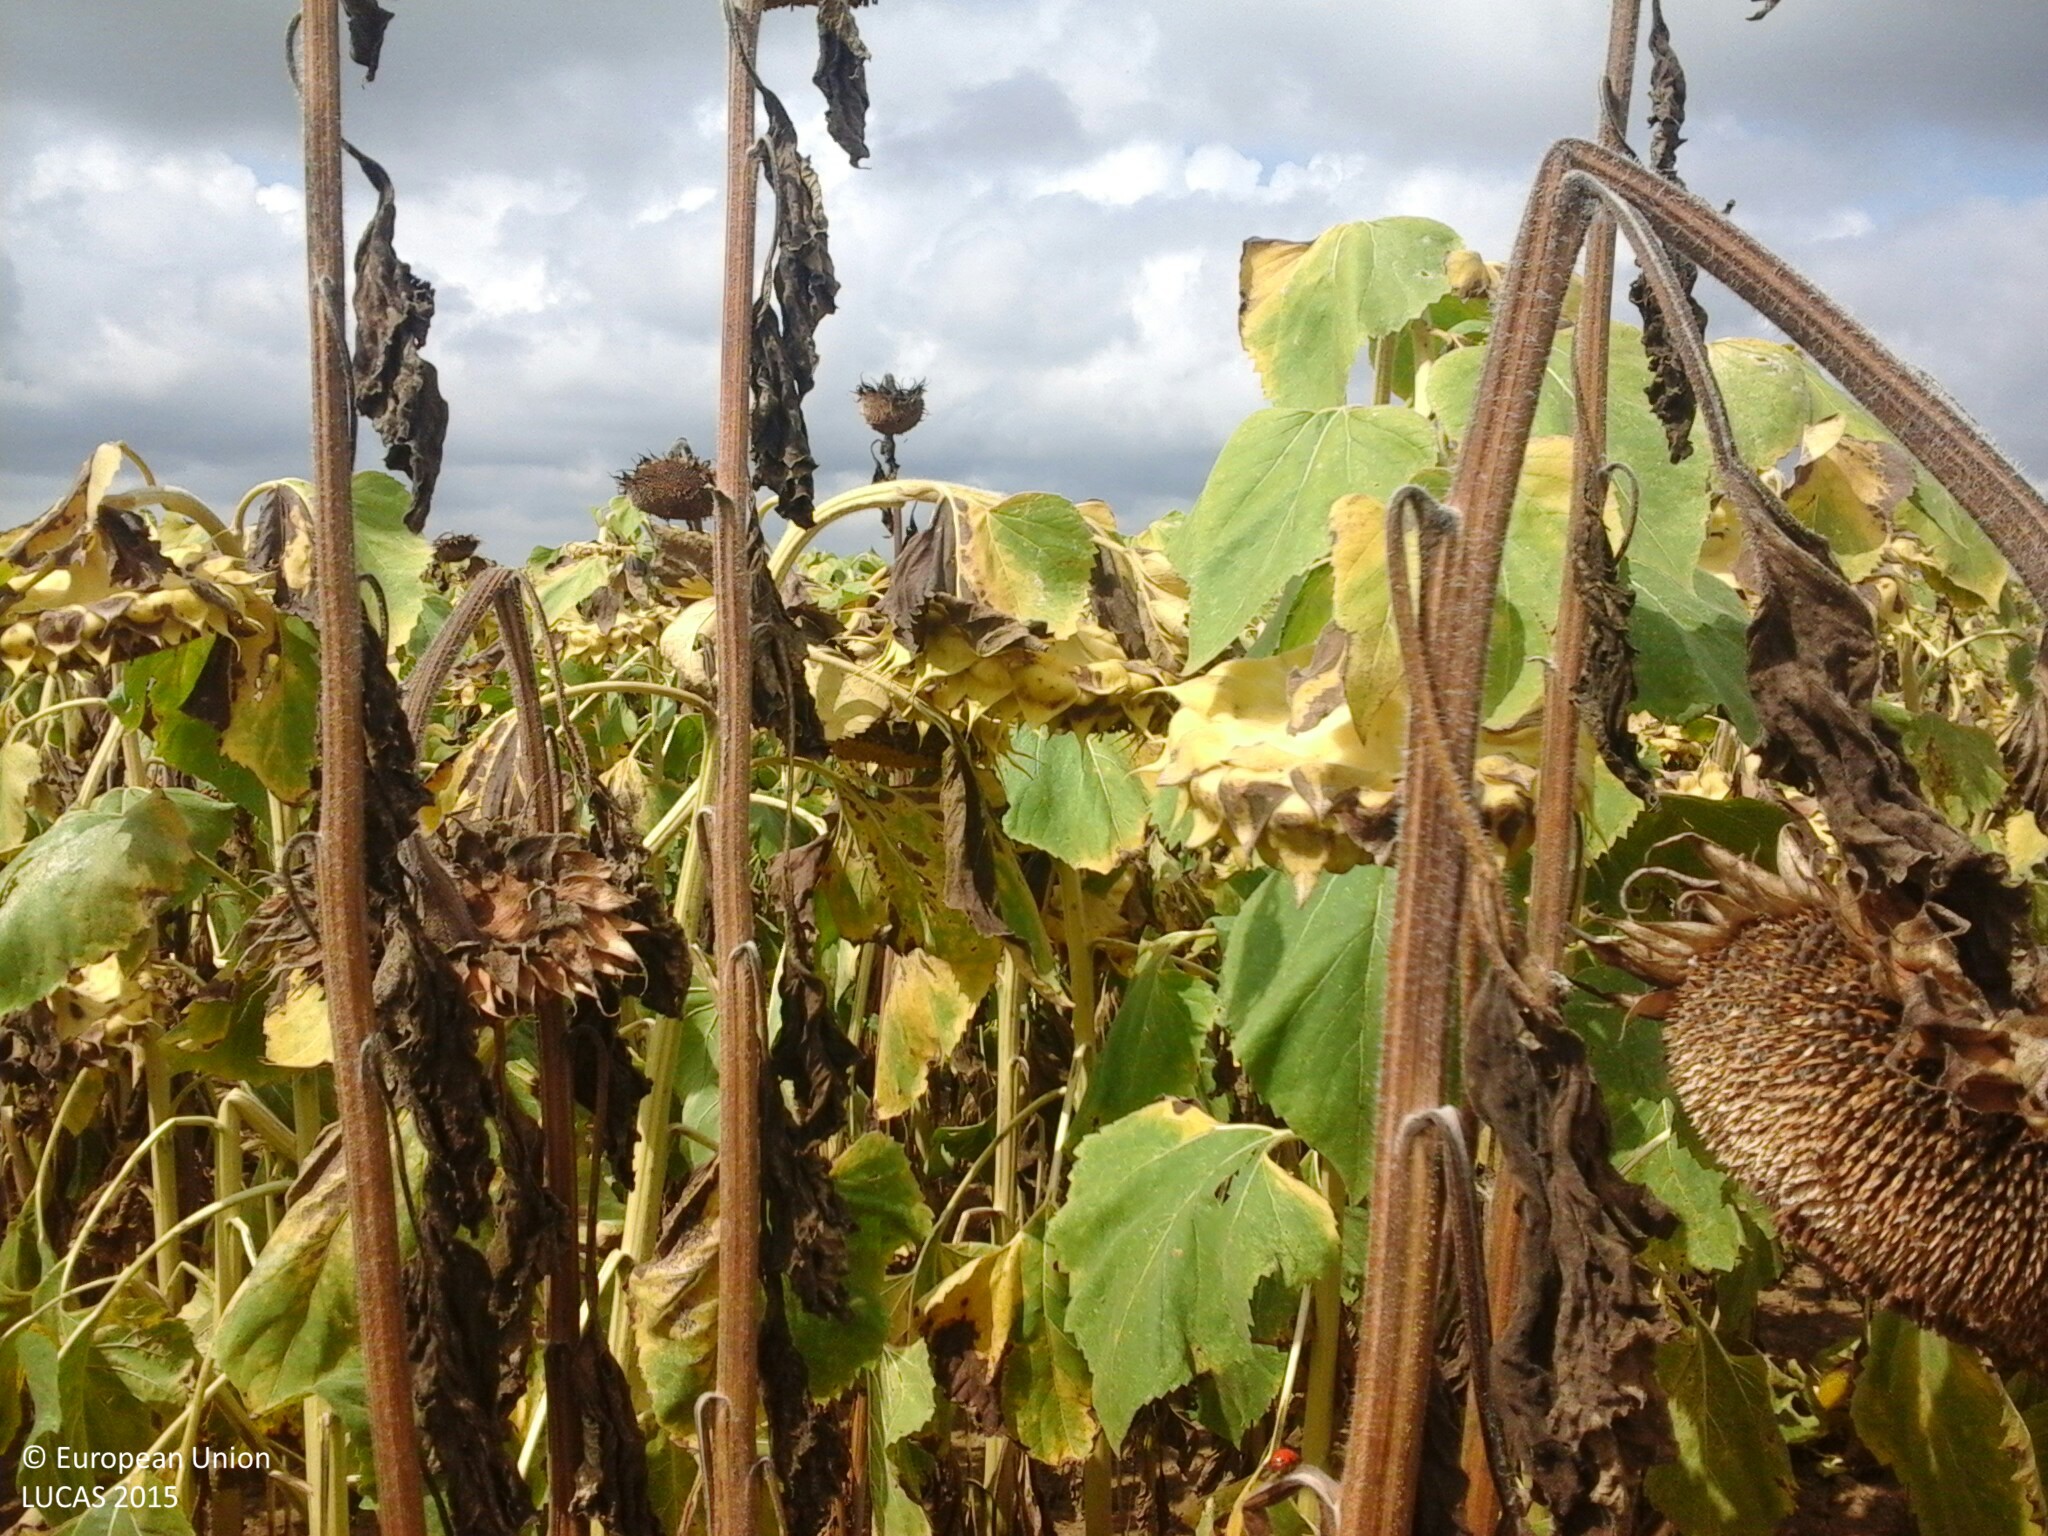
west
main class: Cropland
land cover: Sunflower
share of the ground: > 75 %
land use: Agriculture (excluding fallow land and kitchen gardens)
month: August
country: HU
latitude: 46.9964
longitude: 21.5474
